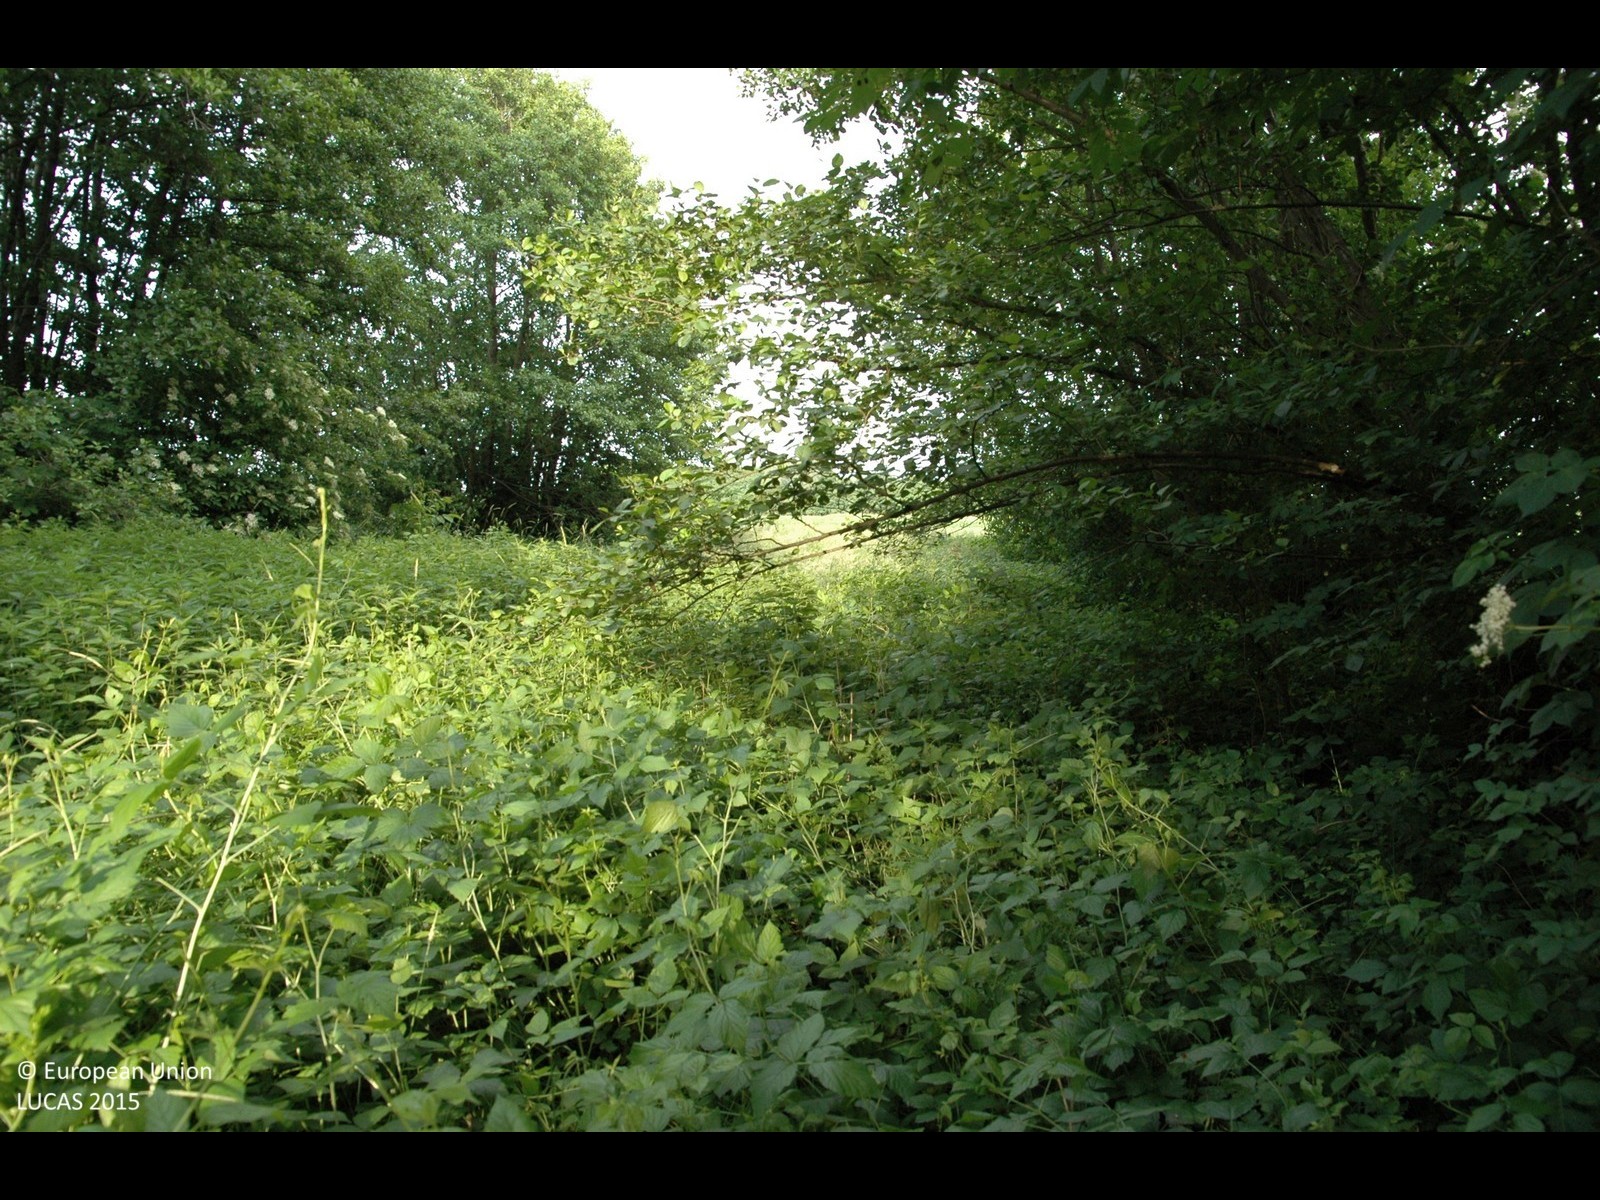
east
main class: Woodland
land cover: Broadleaved woodland
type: mesophytic deciduous forest
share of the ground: > 75 %
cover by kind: shrubs 50 %, broadleaved forest trees 40 %, herbaceous plants 10 %
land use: Forestry
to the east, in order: Broadleaved woodland; Tracks; Maize; Potatoes; Rape and turnip rape; Broadleaved woodland
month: May
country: HR
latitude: 46.3599
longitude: 16.6687
